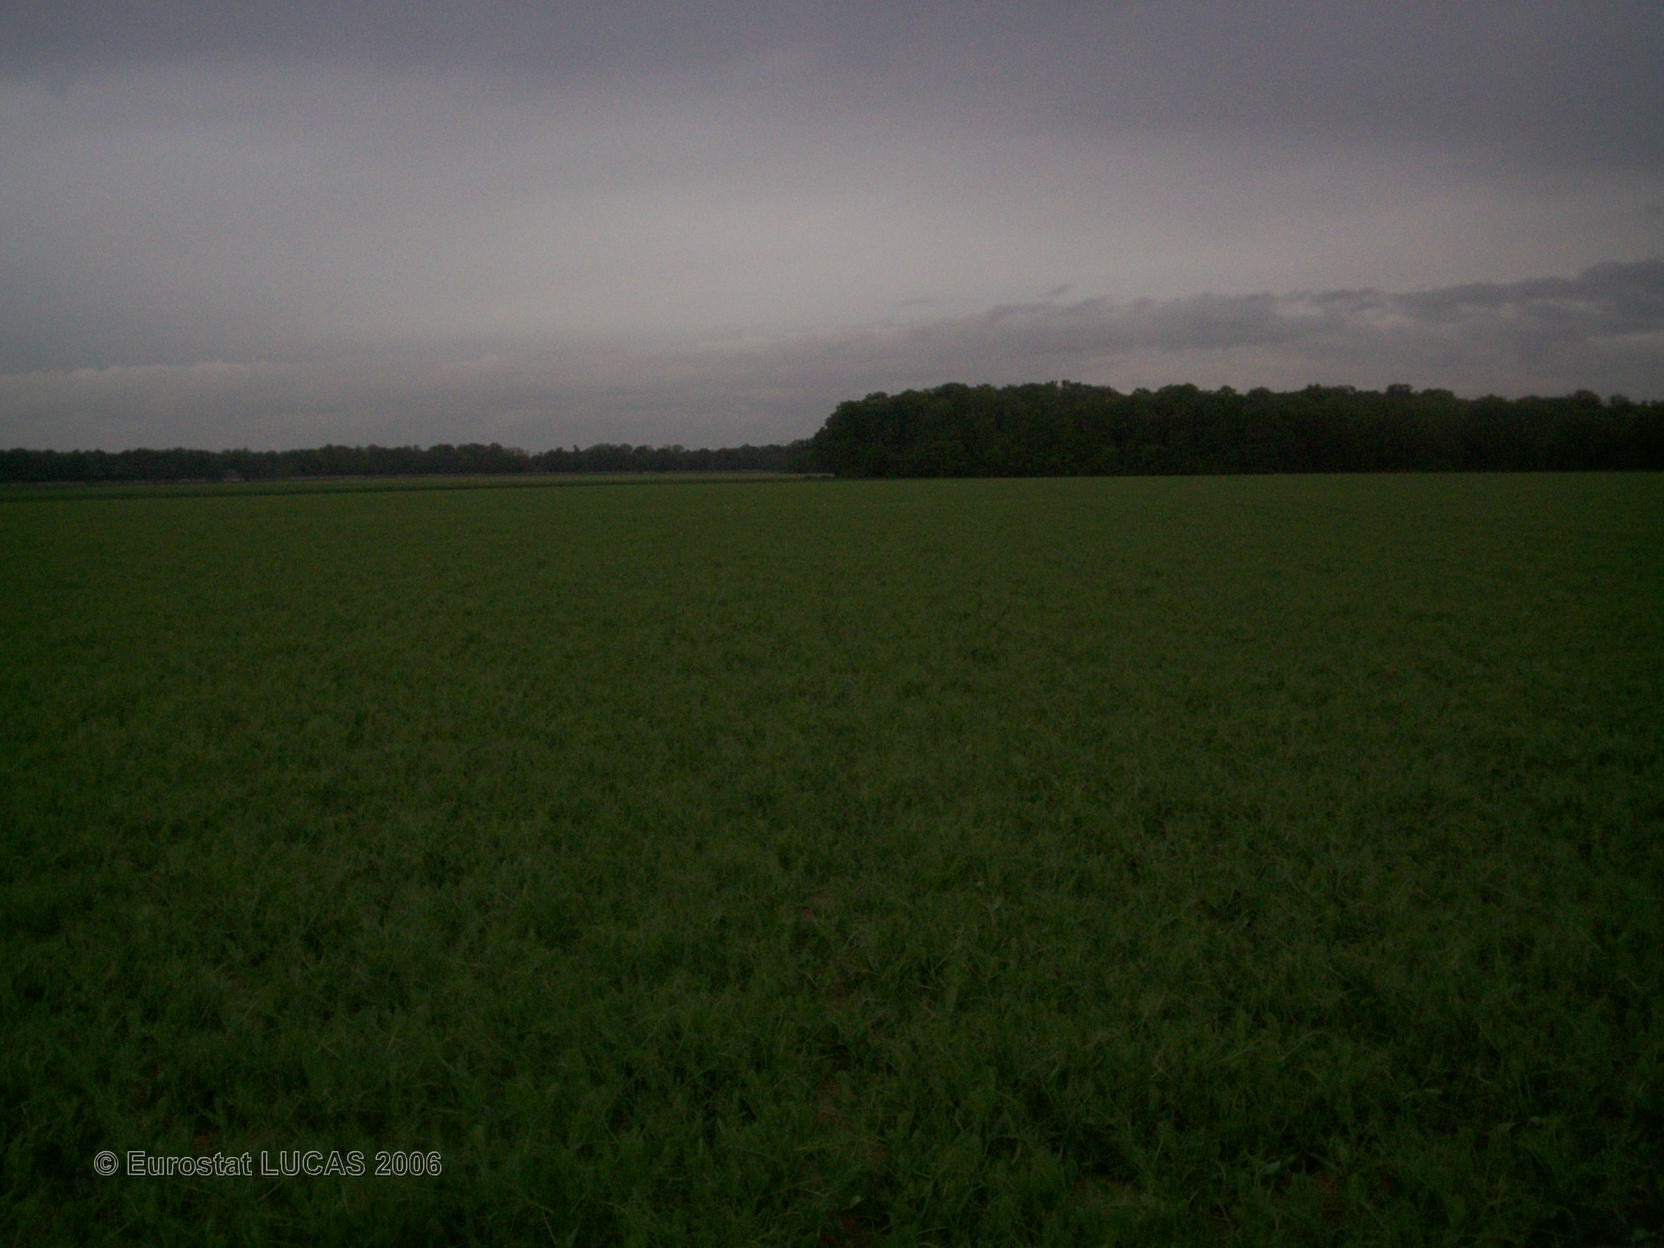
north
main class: Cropland
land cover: Dry pulses
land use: Agriculture (excluding fallow land and kitchen gardens)
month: May
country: FR
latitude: 48.6695
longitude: 2.7254
